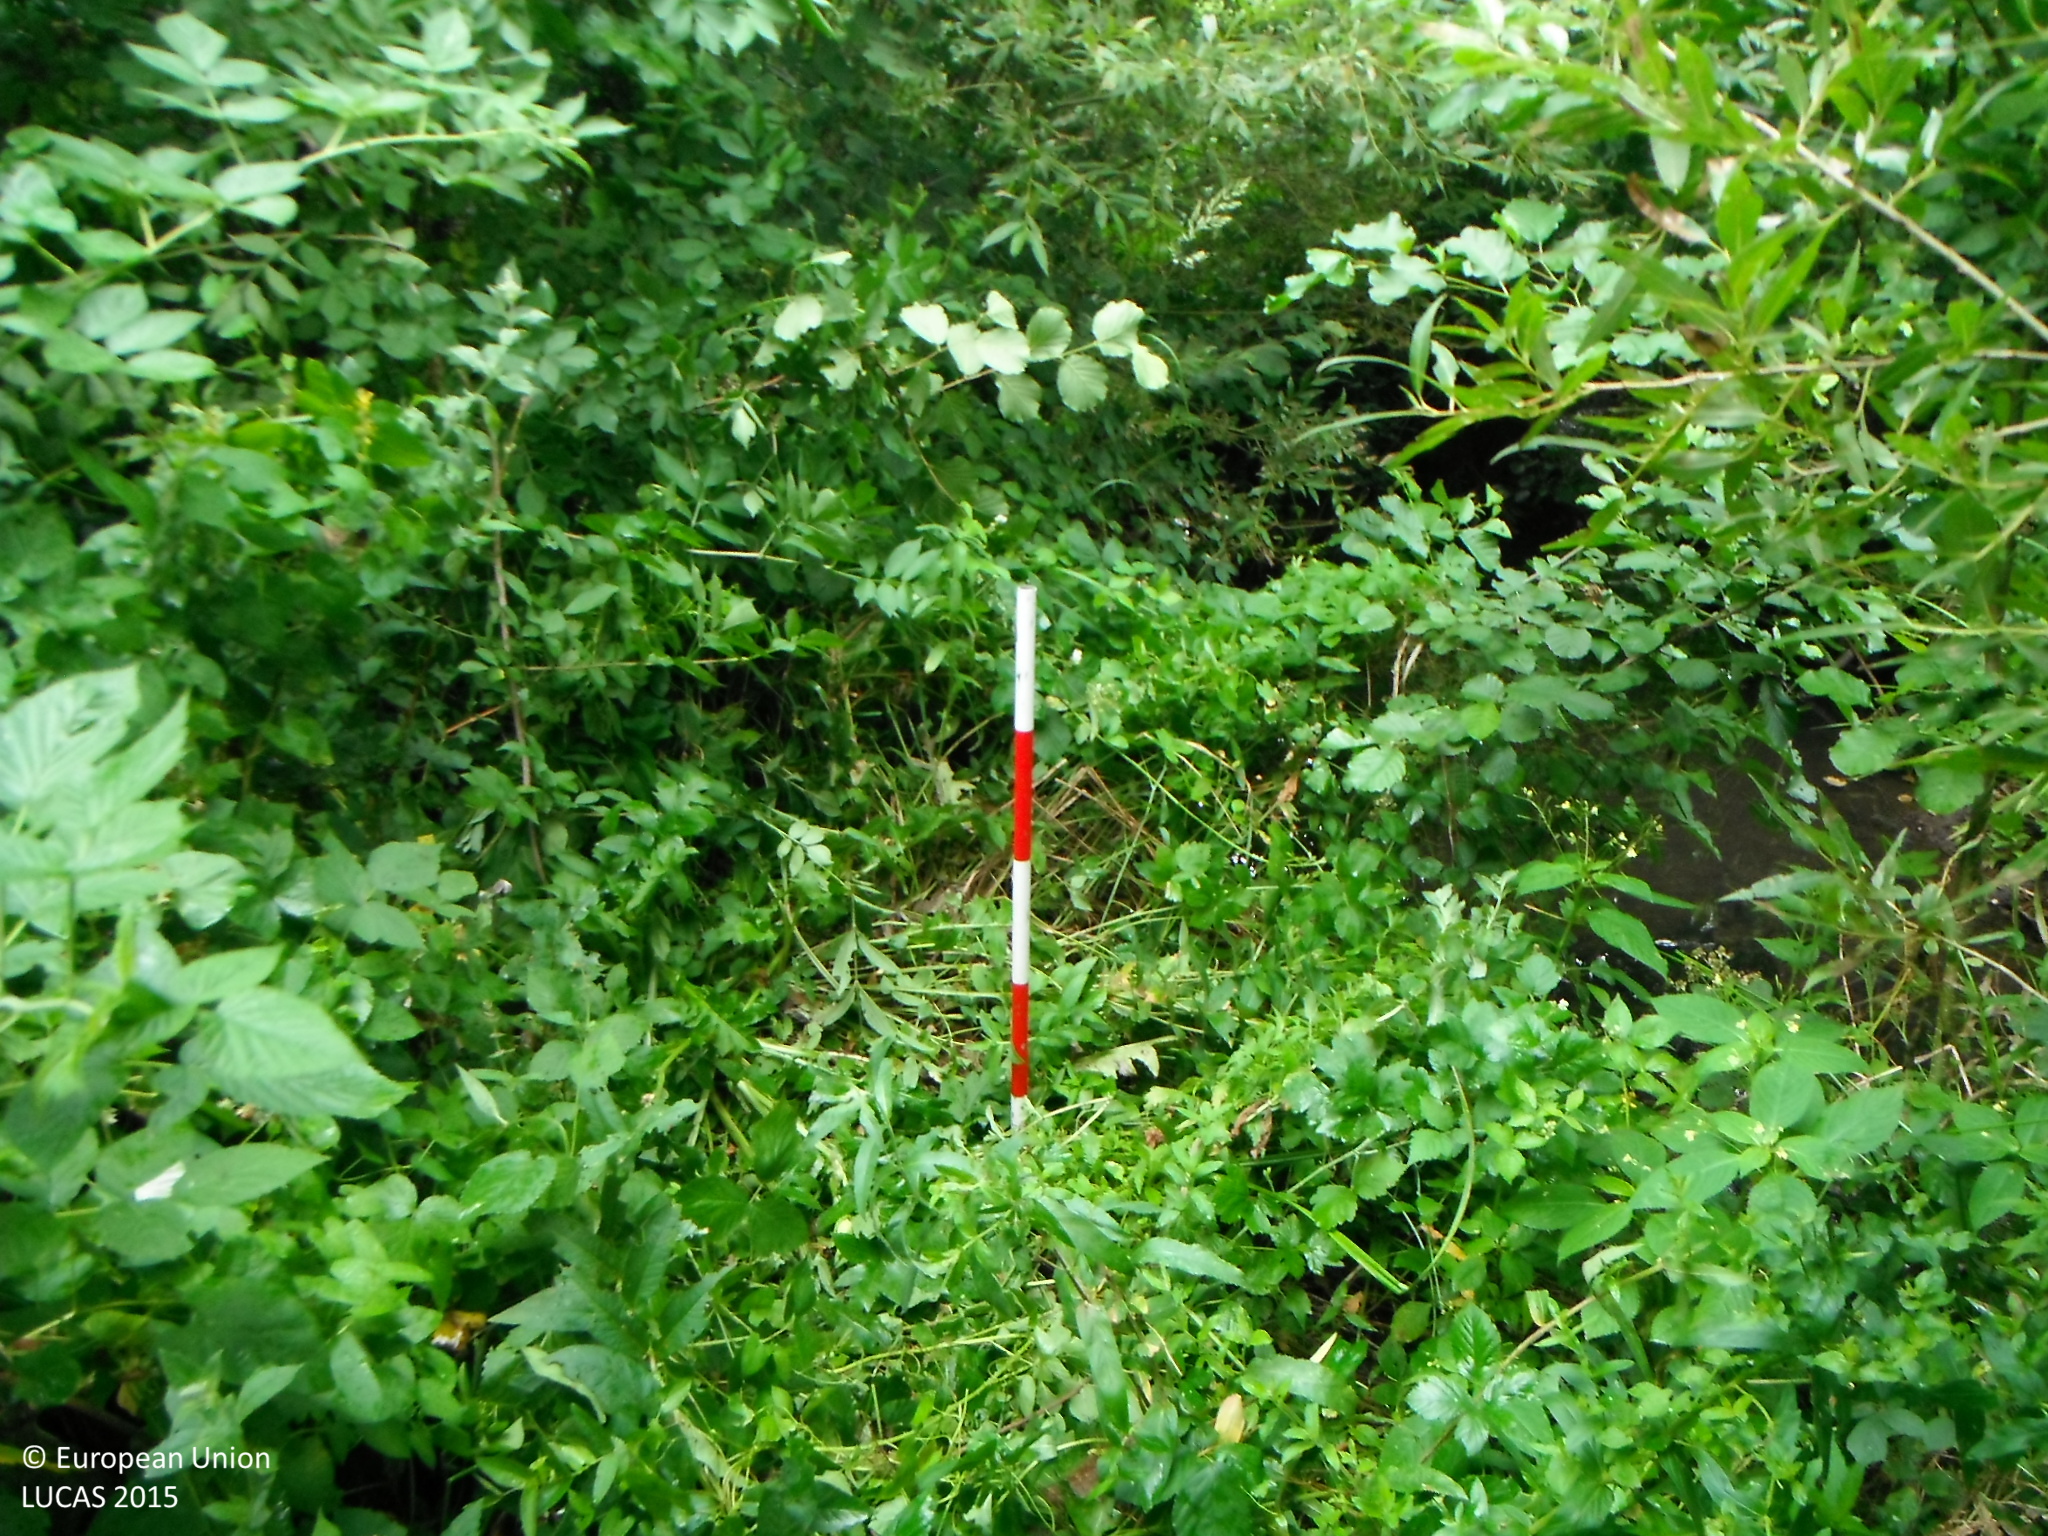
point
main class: Woodland
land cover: Broadleaved woodland
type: floodplain forest
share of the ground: > 75 %
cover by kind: broadleaved forest trees 80 %, shrubs 20 %
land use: Forestry
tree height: > 5 m
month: July
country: SK
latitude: 48.3755
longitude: 19.0526
